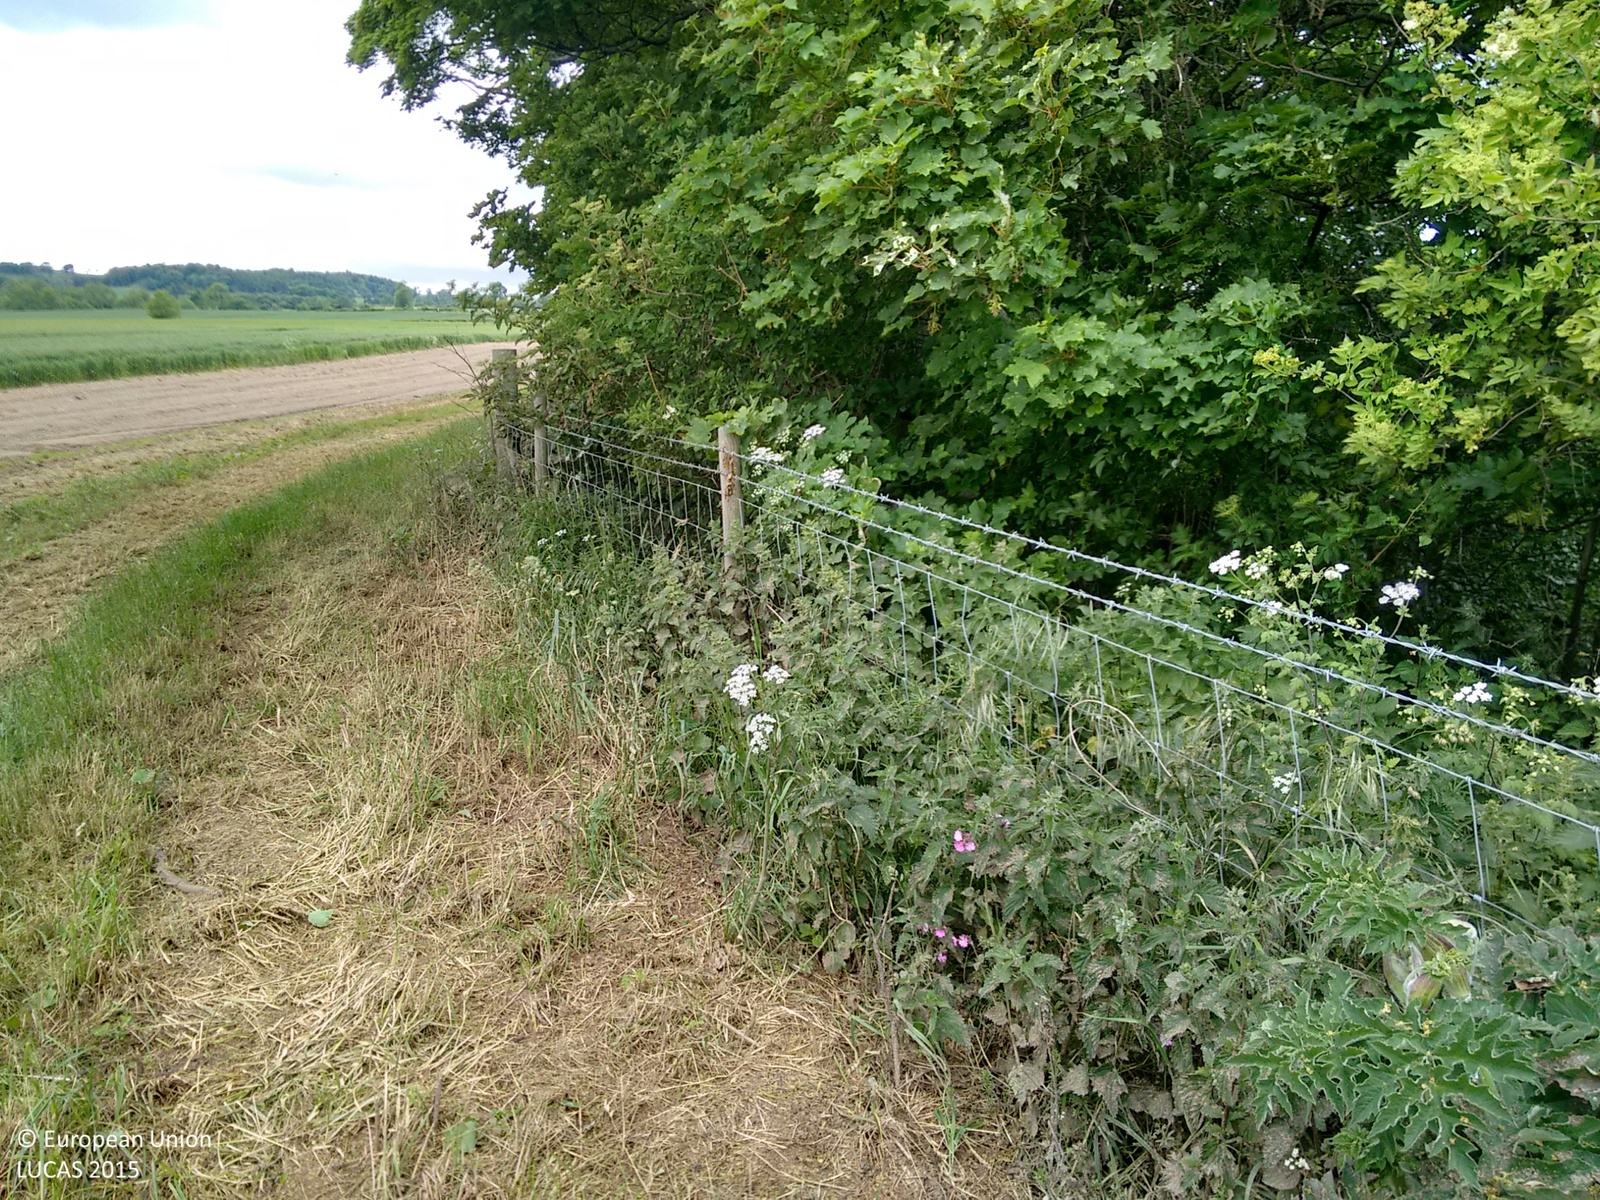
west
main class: Grassland
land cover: Spontaneously vegetated surfaces
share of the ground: > 75 %
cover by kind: herbaceous plants 100 %
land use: Agriculture (excluding fallow land and kitchen gardens)
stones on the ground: > 50 %
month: June
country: GB
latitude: 54.4921
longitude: -1.8328
